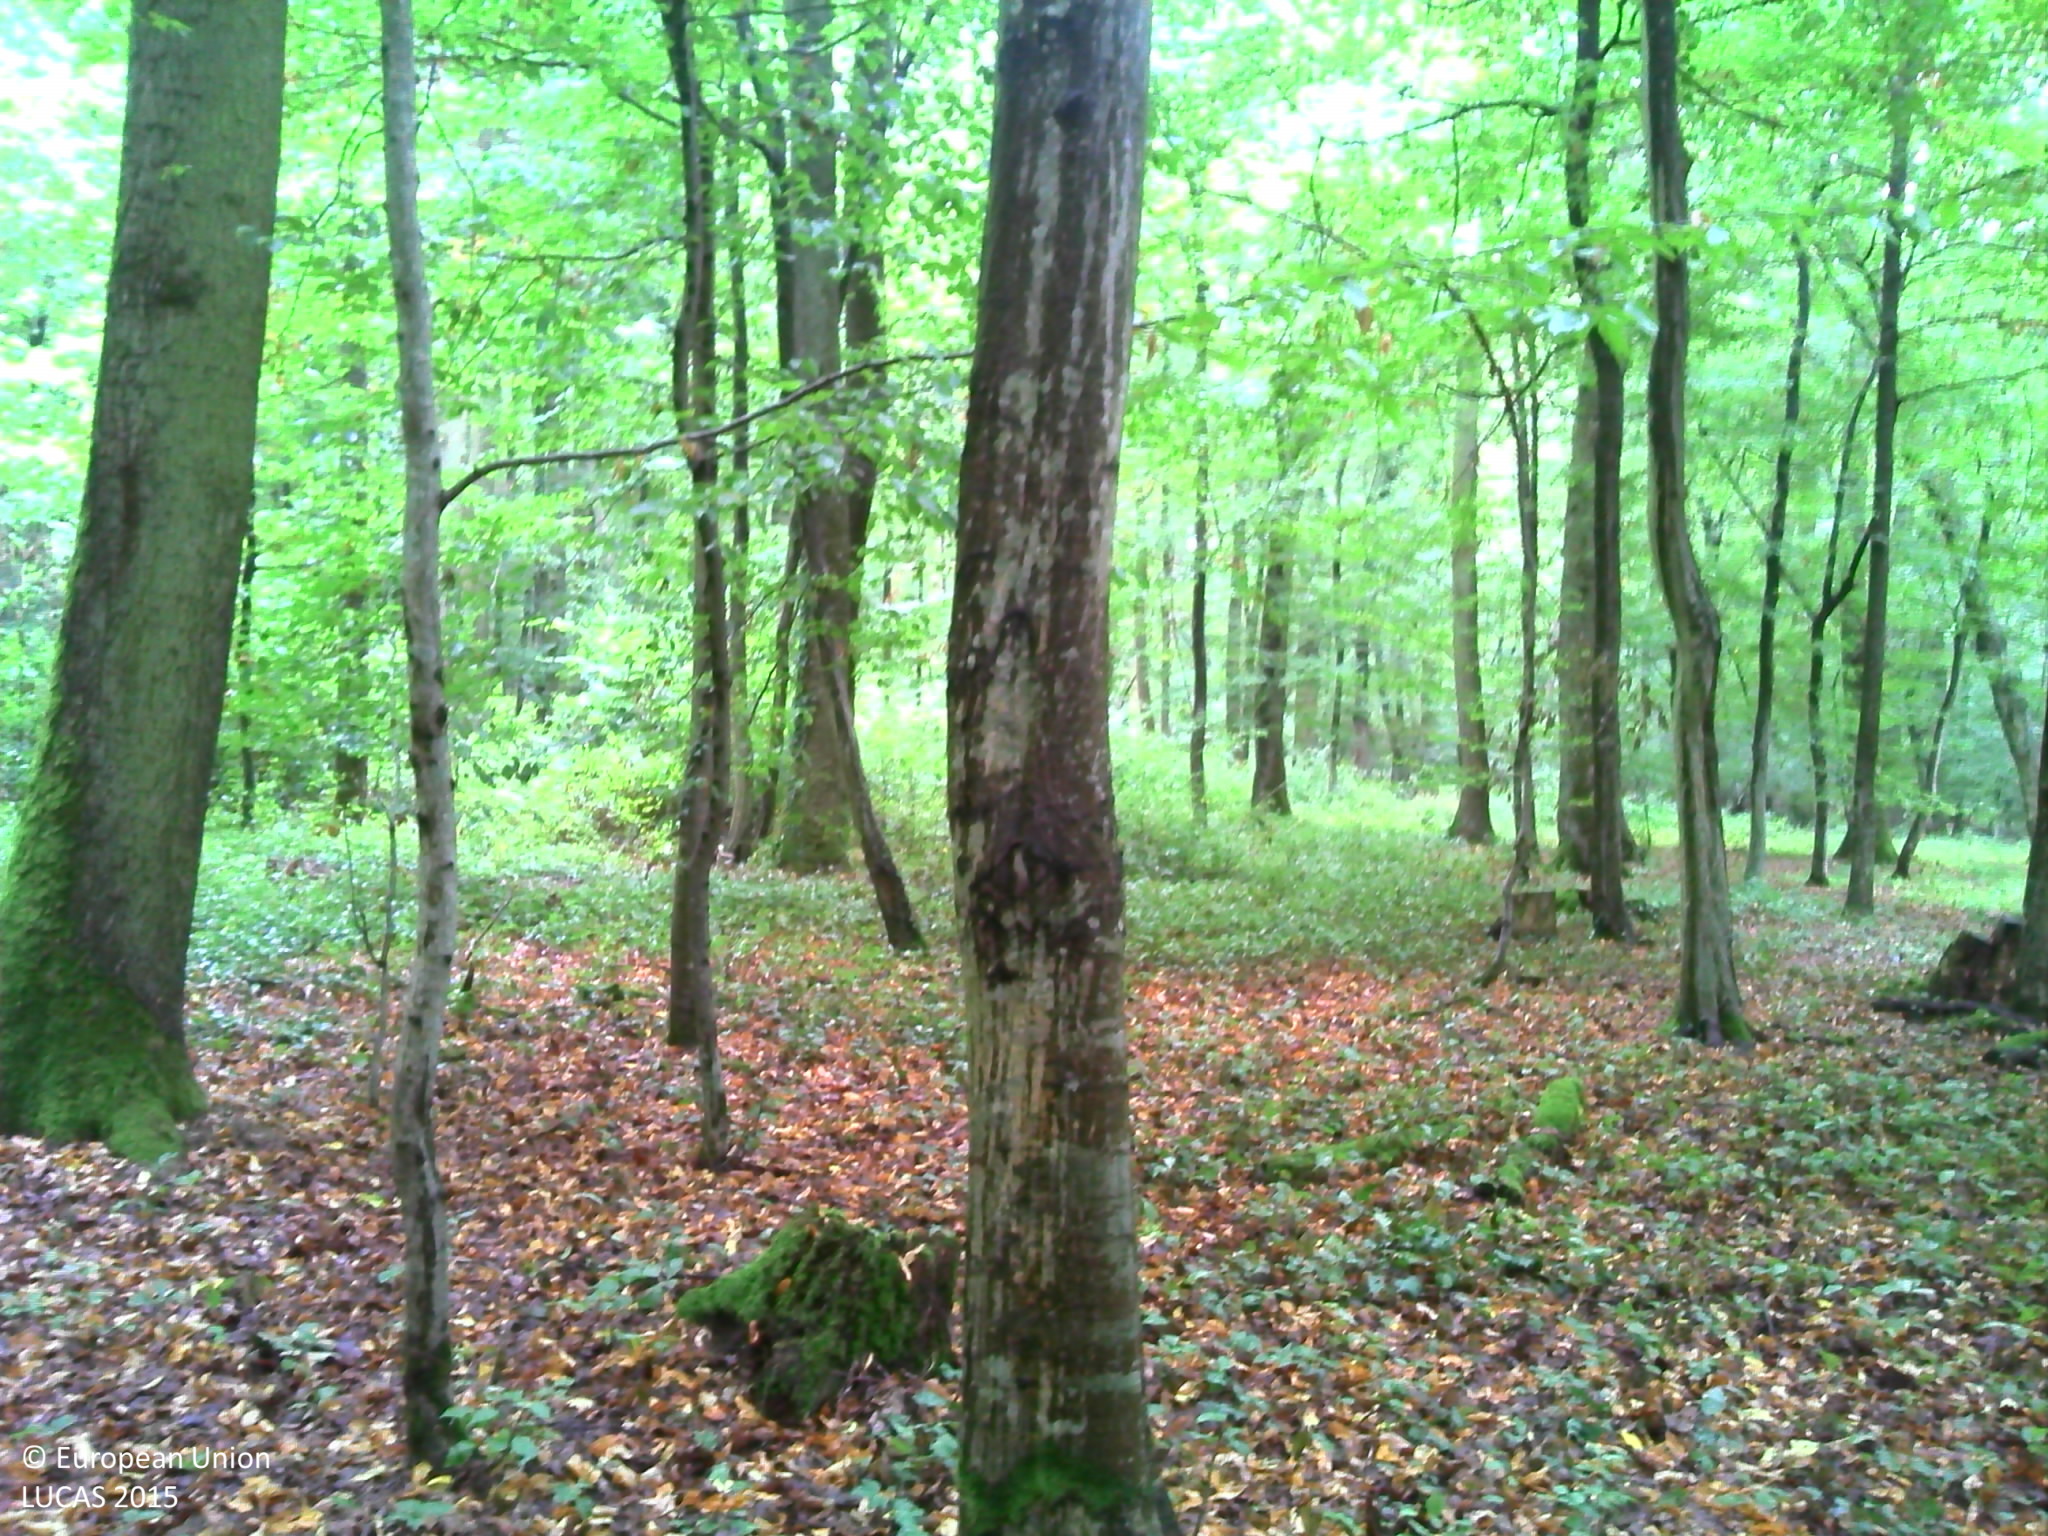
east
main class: Woodland
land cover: Broadleaved woodland
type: mesophytic deciduous forest
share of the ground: > 75 %
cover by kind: broadleaved forest trees 95 %, herbaceous plants 5 %
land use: Forestry
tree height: > 5 m
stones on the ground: < 10 %
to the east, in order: Broadleaved woodland; Tracks; Broadleaved woodland; Fences; Broadleaved woodland; Fences; Broadleaved woodland; Tracks; Broadleaved woodland; Tracks; Broadleaved woodland; Fences; Grassland without tree/shrub cover
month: August
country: FR
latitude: 48.7895
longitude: 7.5098
